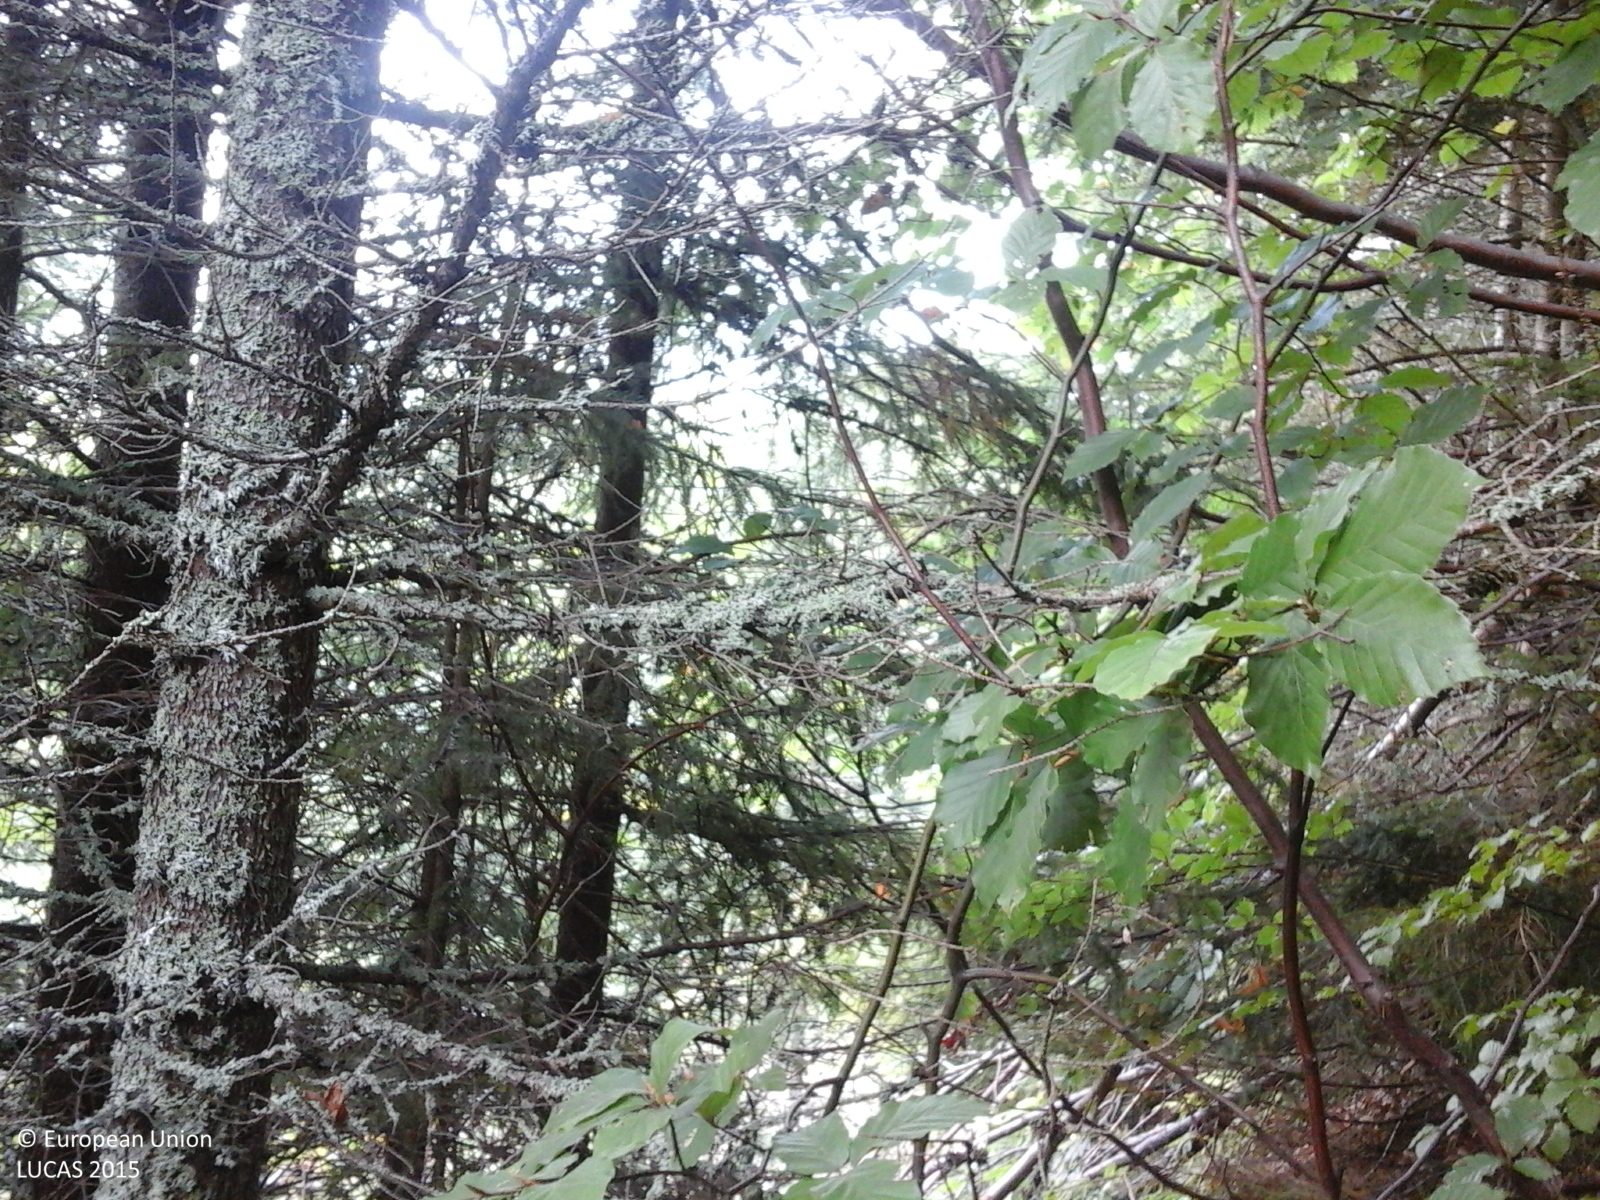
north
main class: Woodland
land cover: Spruce dominated mixed woodland
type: alpine coniferous forest
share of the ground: > 75 %
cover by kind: coniferous forest trees 60 %, broadleaved forest trees 40 %
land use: Forestry
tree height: > 5 m
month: September
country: RO
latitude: 45.2731
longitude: 22.9112
